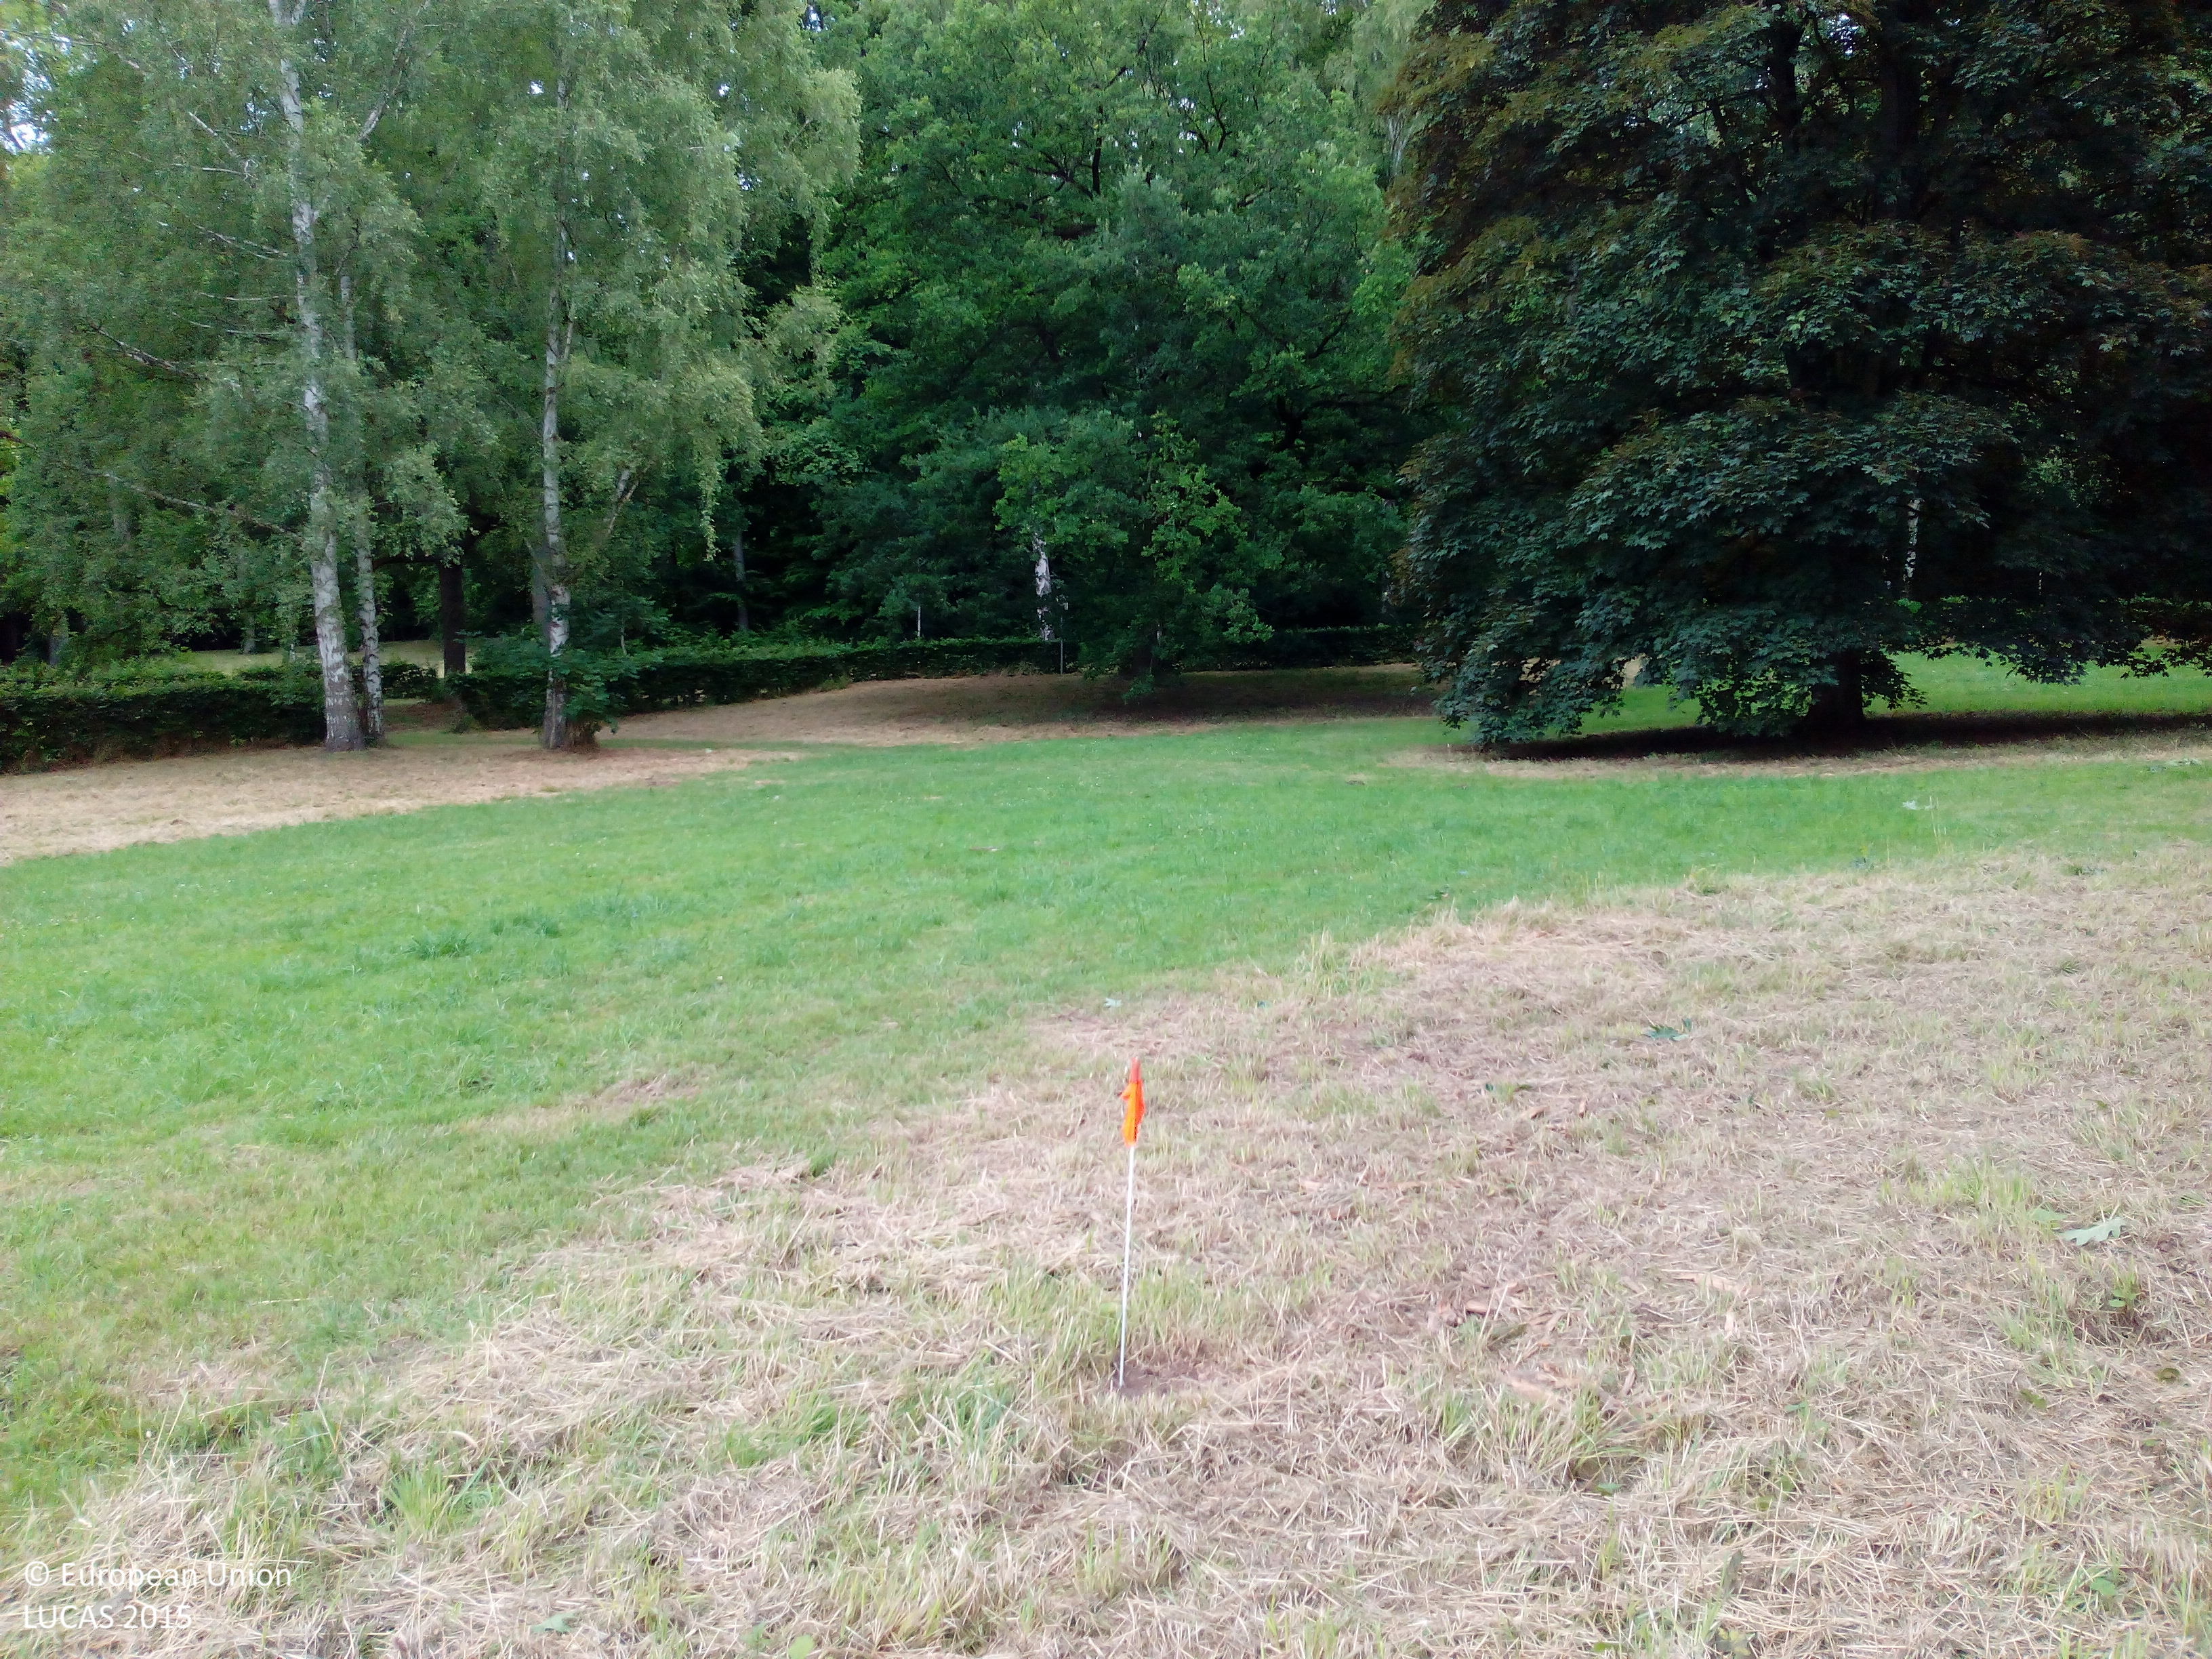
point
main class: Grassland
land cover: Grassland without tree/shrub cover
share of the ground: > 75 %
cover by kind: herbaceous plants 100 %
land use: Community services
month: July
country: DE
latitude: 51.5326
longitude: 9.9568
